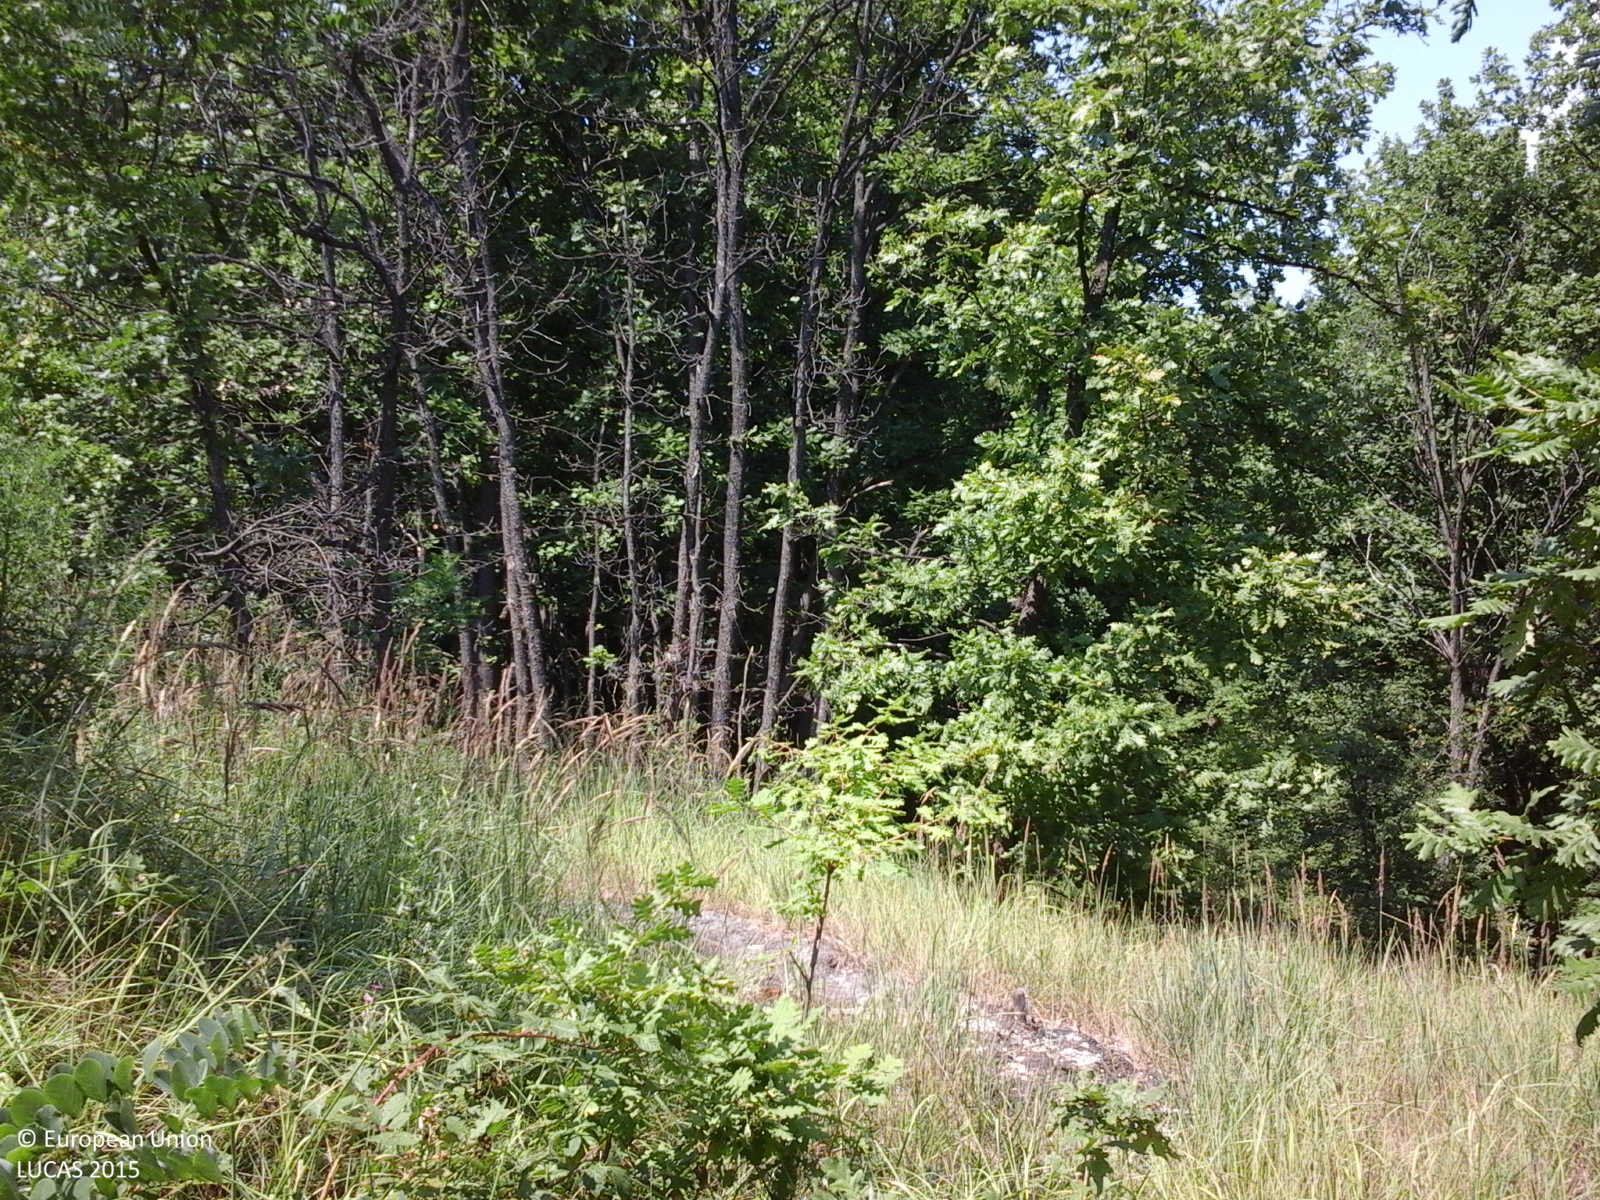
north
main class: Woodland
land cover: Broadleaved woodland
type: acidophilous oak and oak-birch forest
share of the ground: > 75 %
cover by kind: broadleaved forest trees 80 %, shrubs 10 %, herbaceous plants 10 %
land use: Forestry
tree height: > 5 m
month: July
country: RO
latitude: 44.7234
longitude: 24.5811
